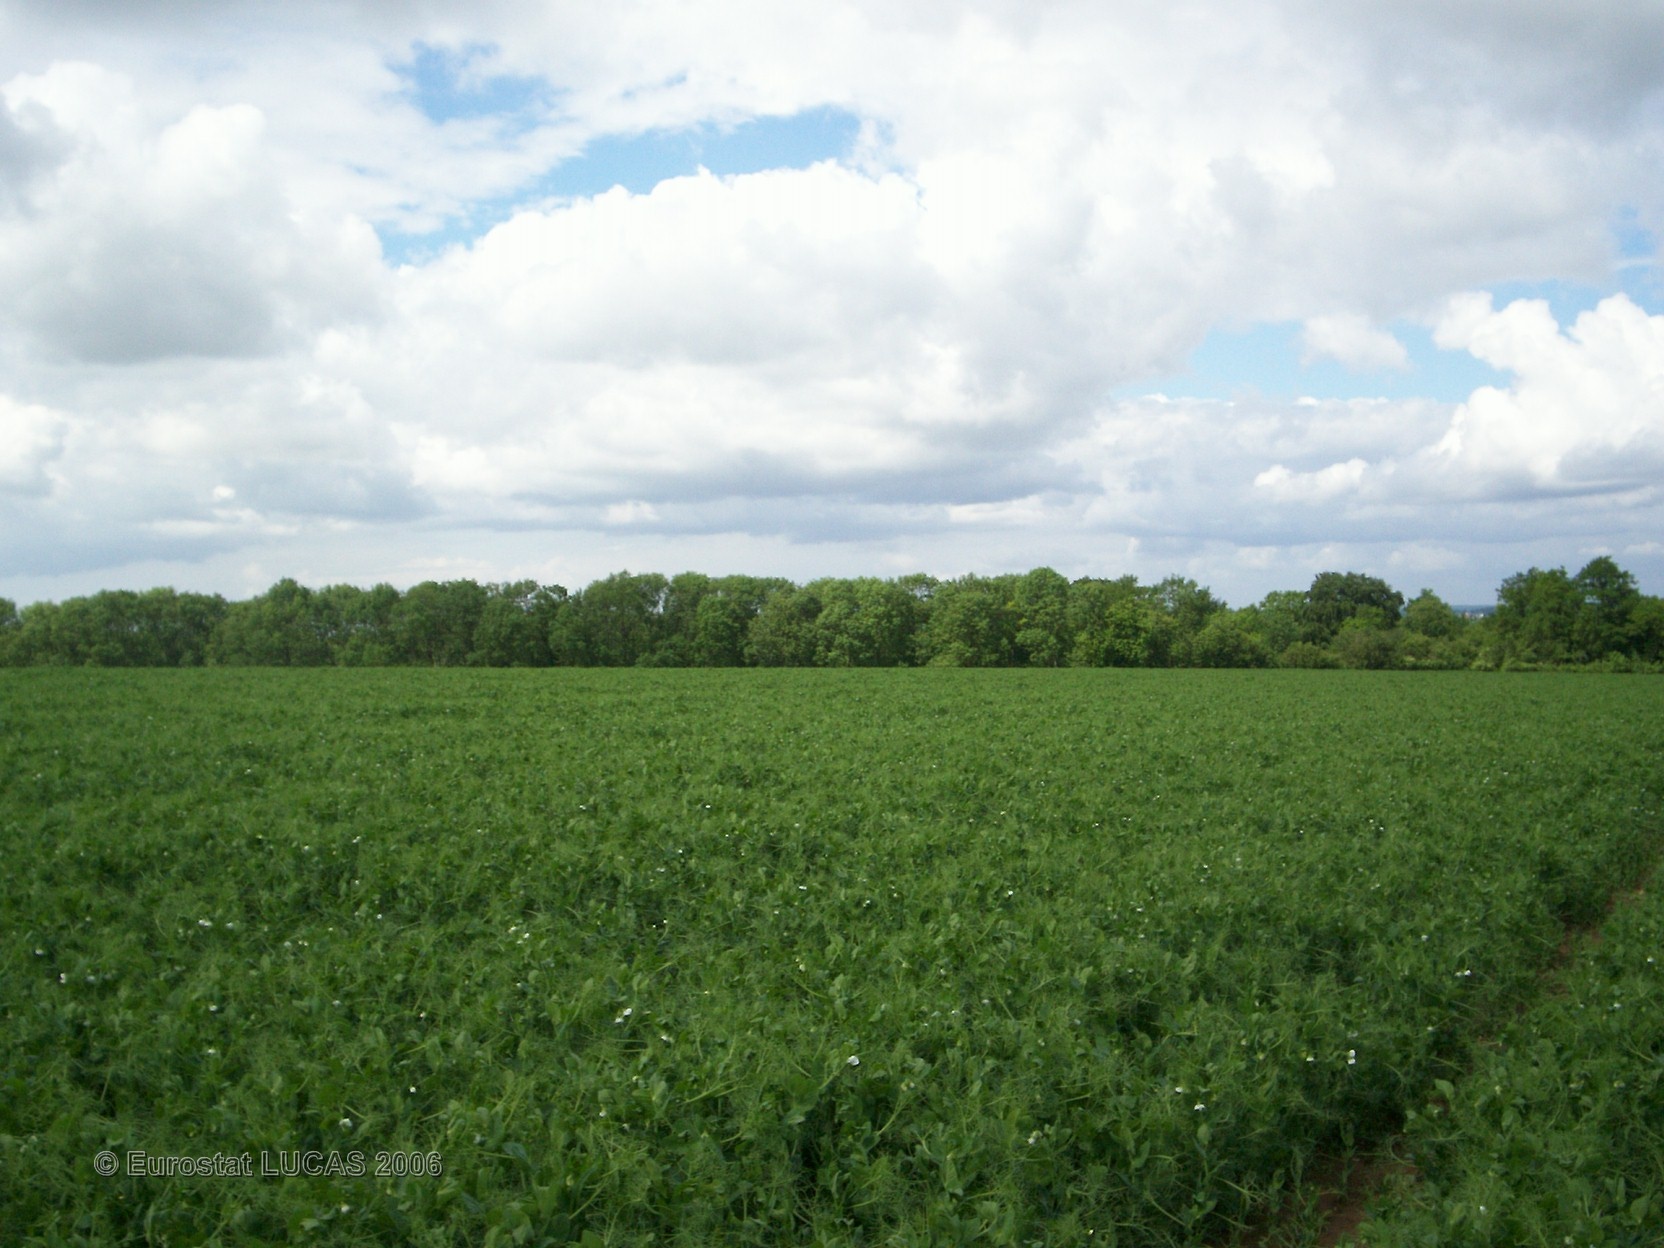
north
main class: Cropland
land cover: Dry pulses
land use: Agriculture (excluding fallow land and kitchen gardens)
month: May
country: FR
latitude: 49.1972
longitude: 2.7851
